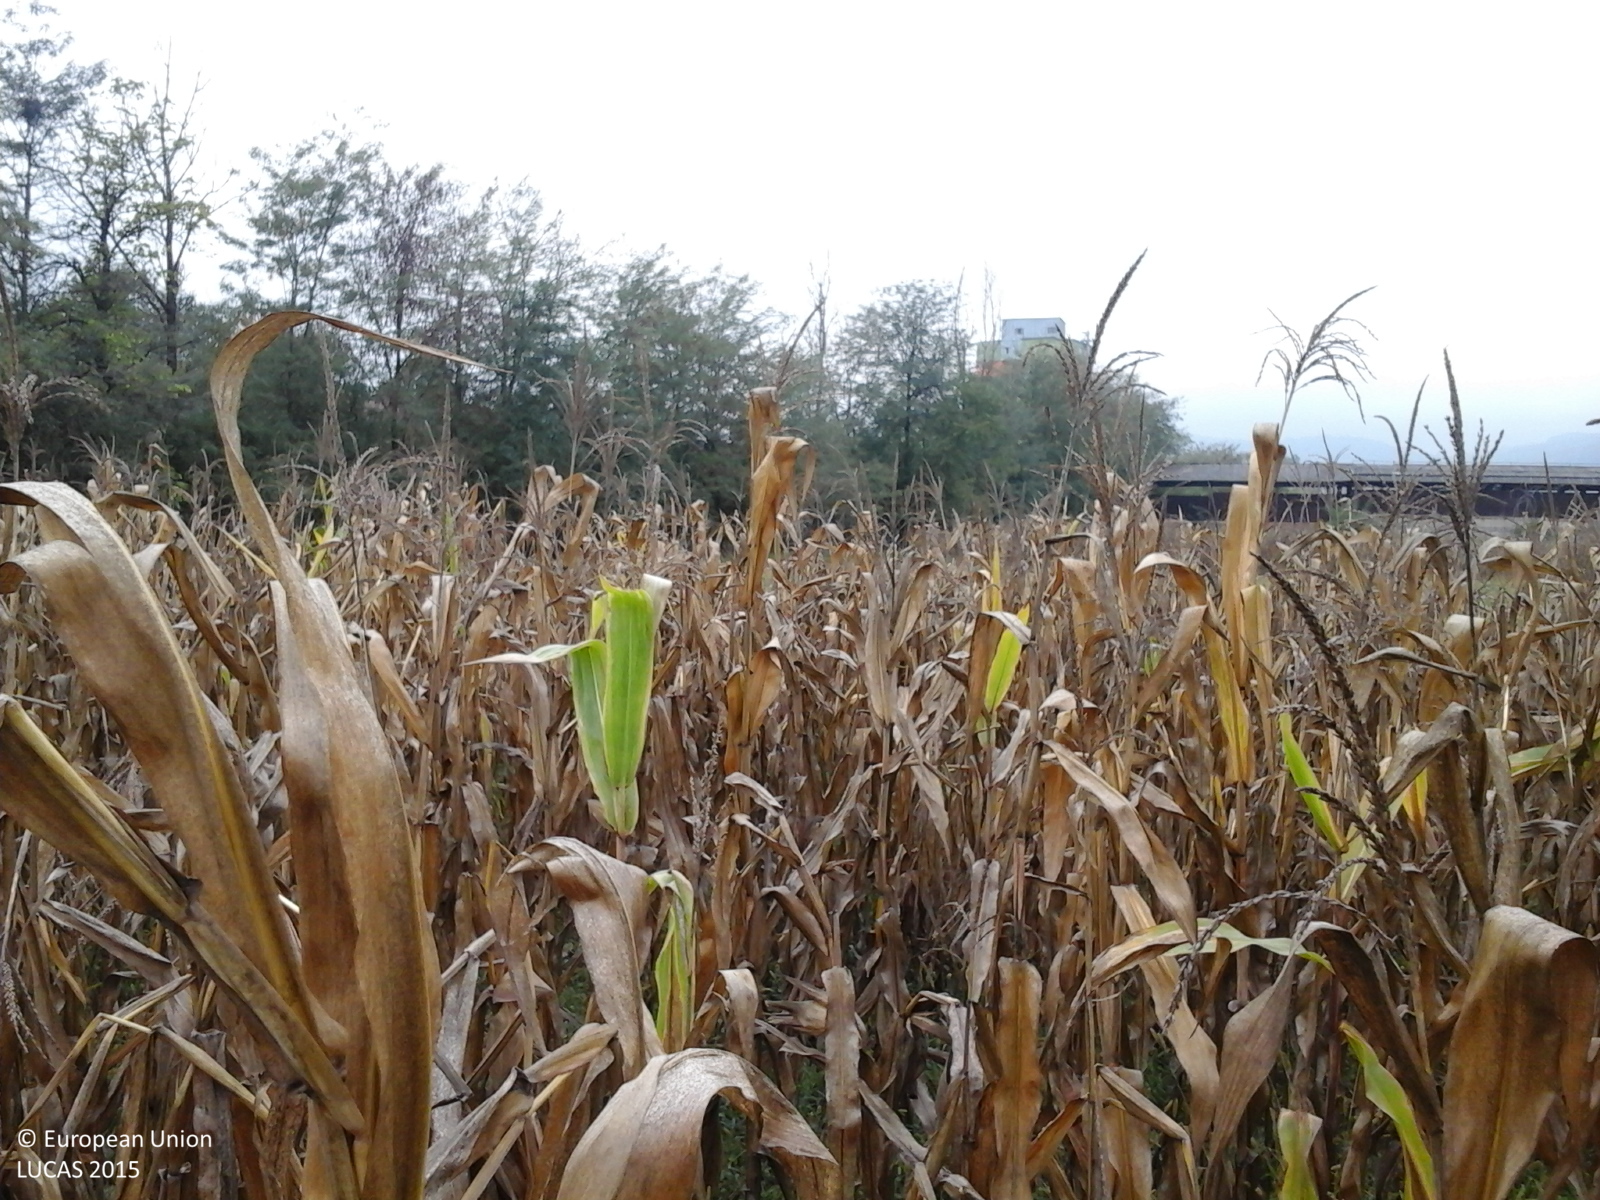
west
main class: Cropland
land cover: Maize
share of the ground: > 75 %
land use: Agriculture (excluding fallow land and kitchen gardens)
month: September
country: RO
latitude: 45.9179
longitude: 22.8565
